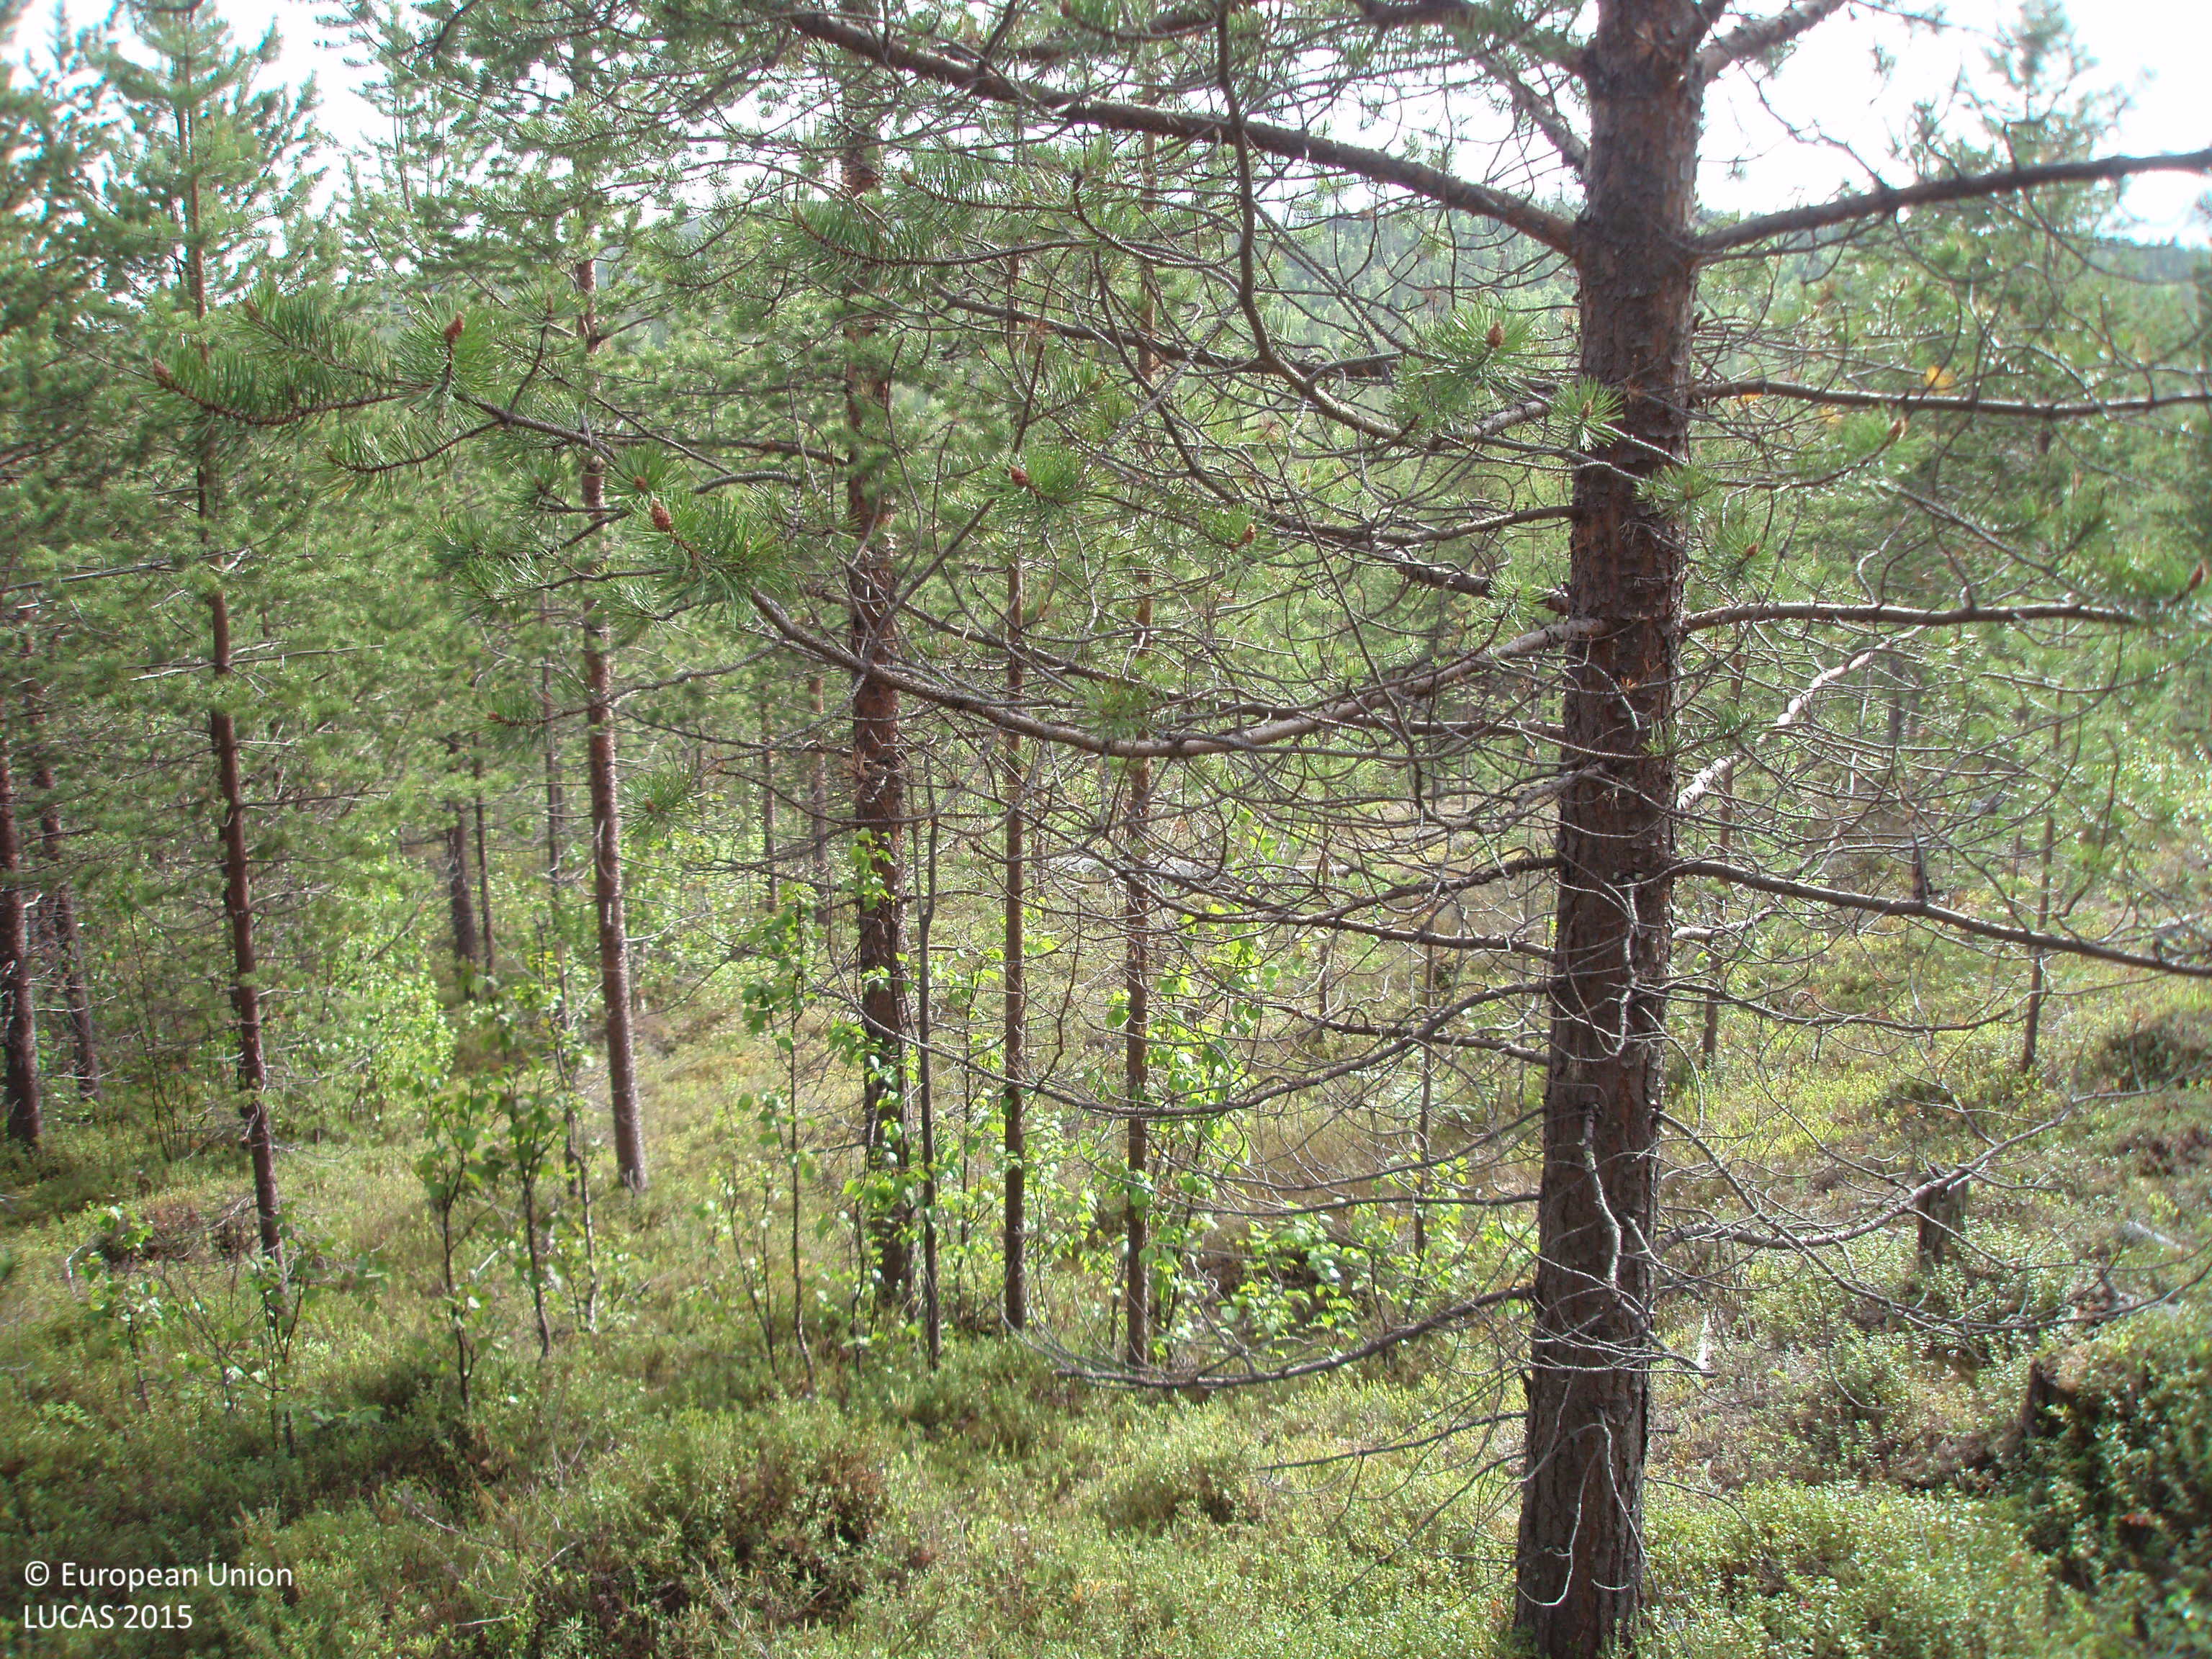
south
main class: Woodland
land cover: Pine dominated coniferous woodland
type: boreal forest
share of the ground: > 75 %
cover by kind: coniferous forest trees 70 %, shrubs 15 %, broadleaved forest trees 10 %, herbaceous plants 5 %
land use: Forestry
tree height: > 5 m
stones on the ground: < 10 %
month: June
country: FI
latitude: 68.9065
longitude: 26.8620
